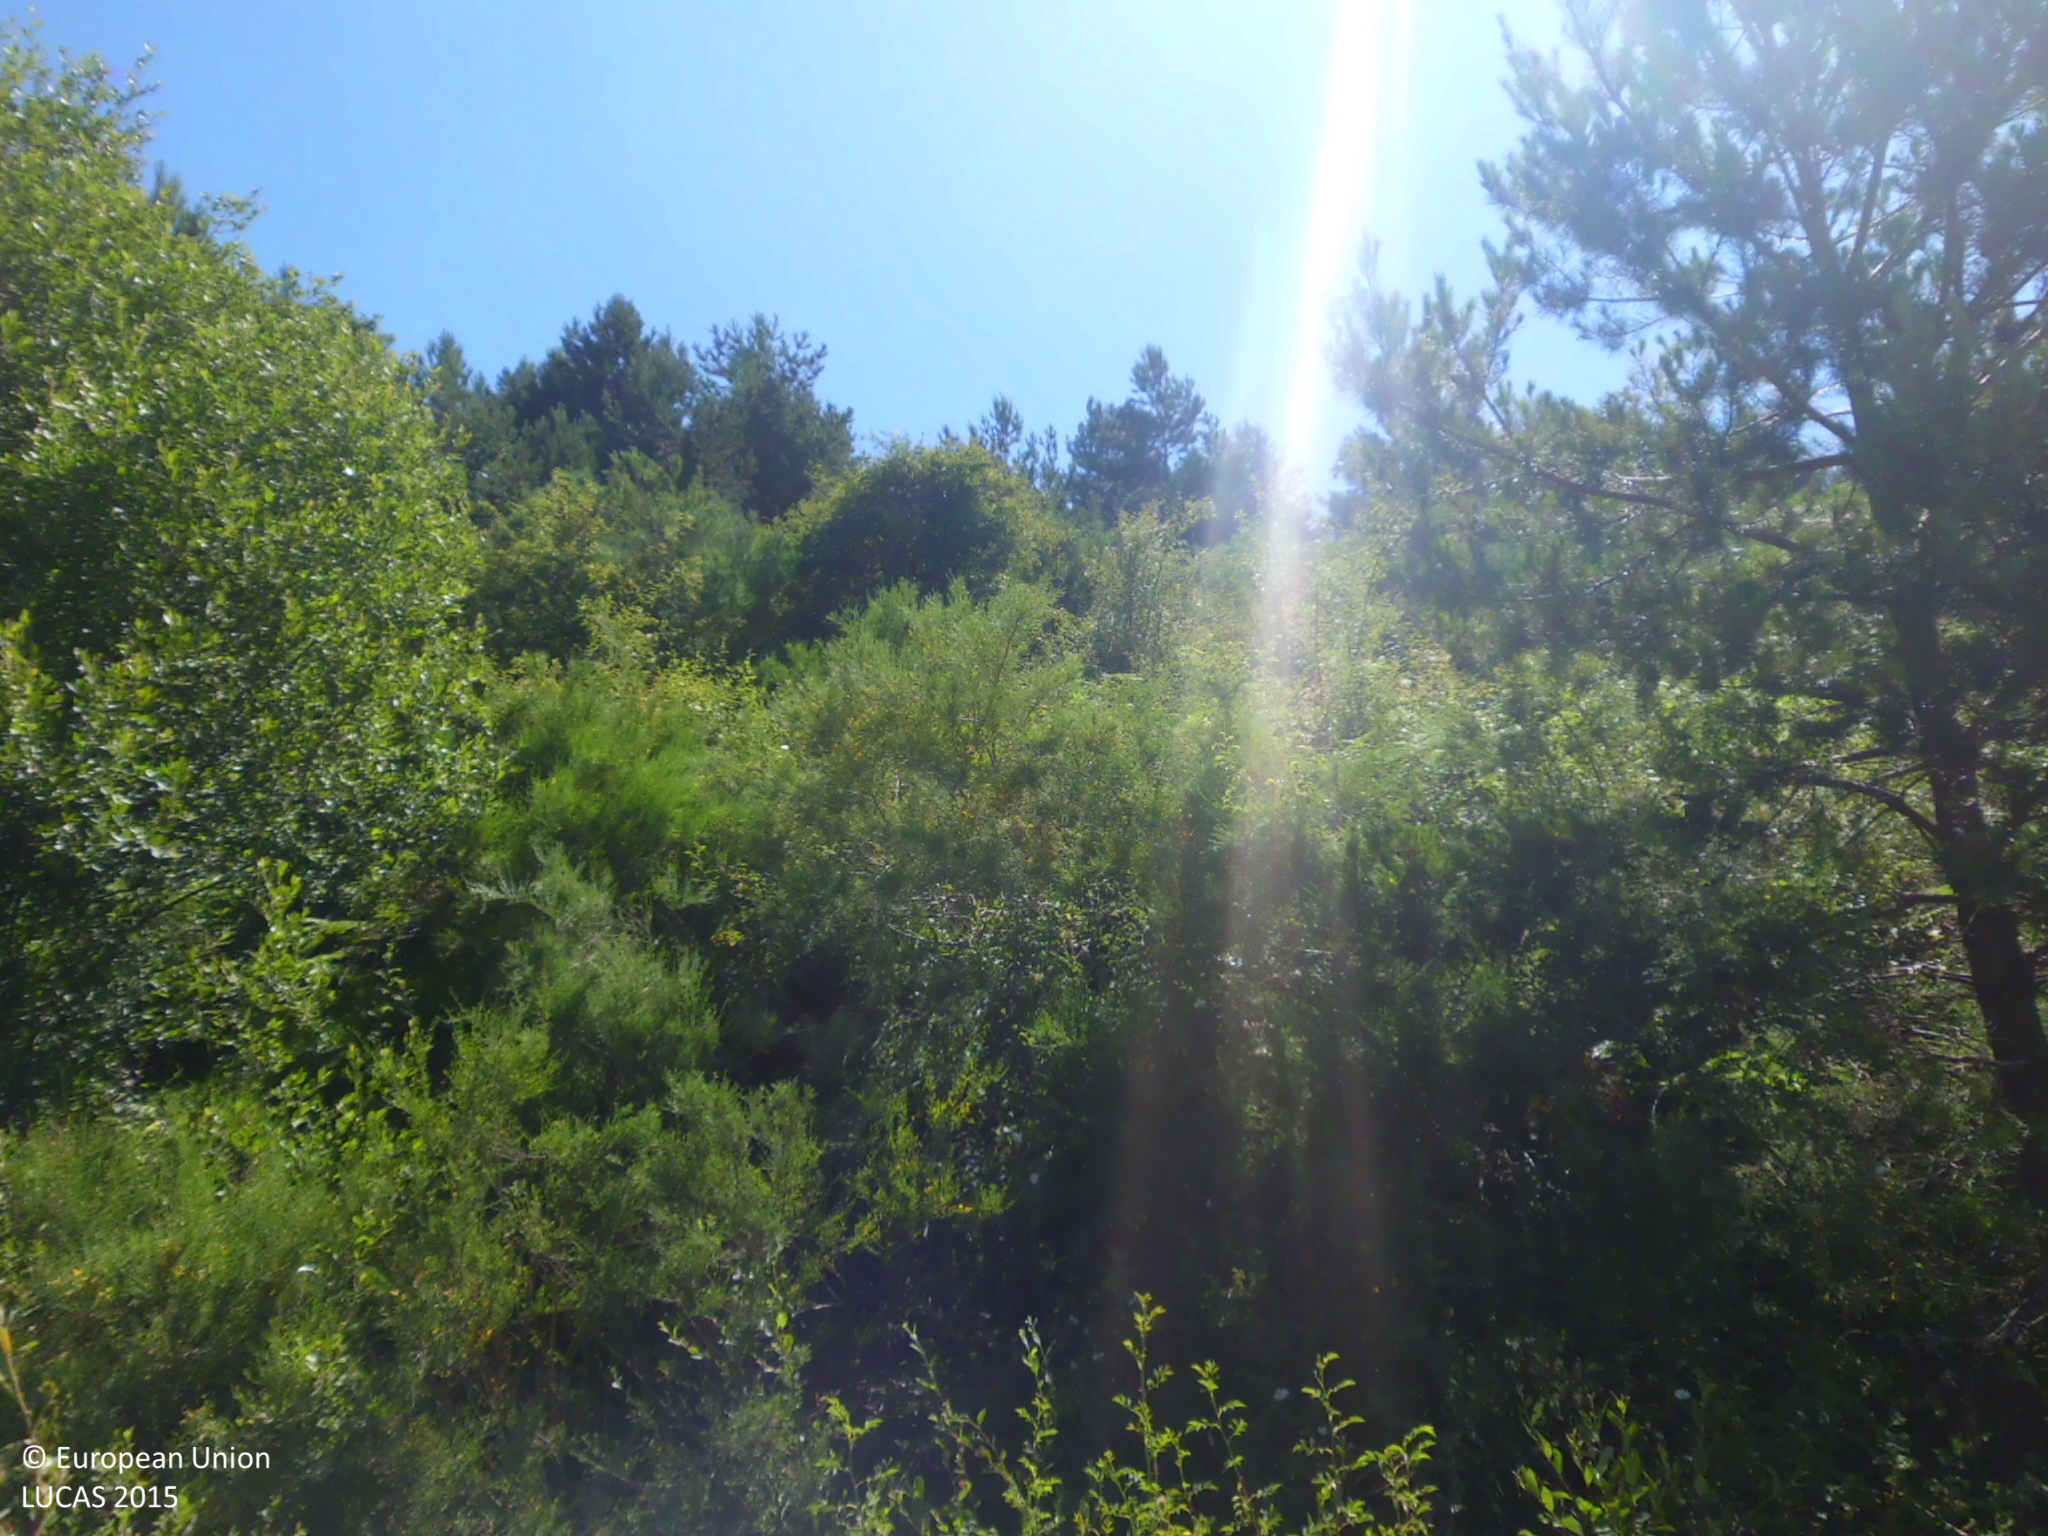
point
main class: Woodland
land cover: Pine dominated mixed woodland
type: coniferous forest of the mediterranean region
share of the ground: > 75 %
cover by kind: coniferous forest trees 60 %, broadleaved forest trees 40 %
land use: Forestry
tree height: > 5 m
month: June
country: ES
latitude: 42.8067
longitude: -4.9197
